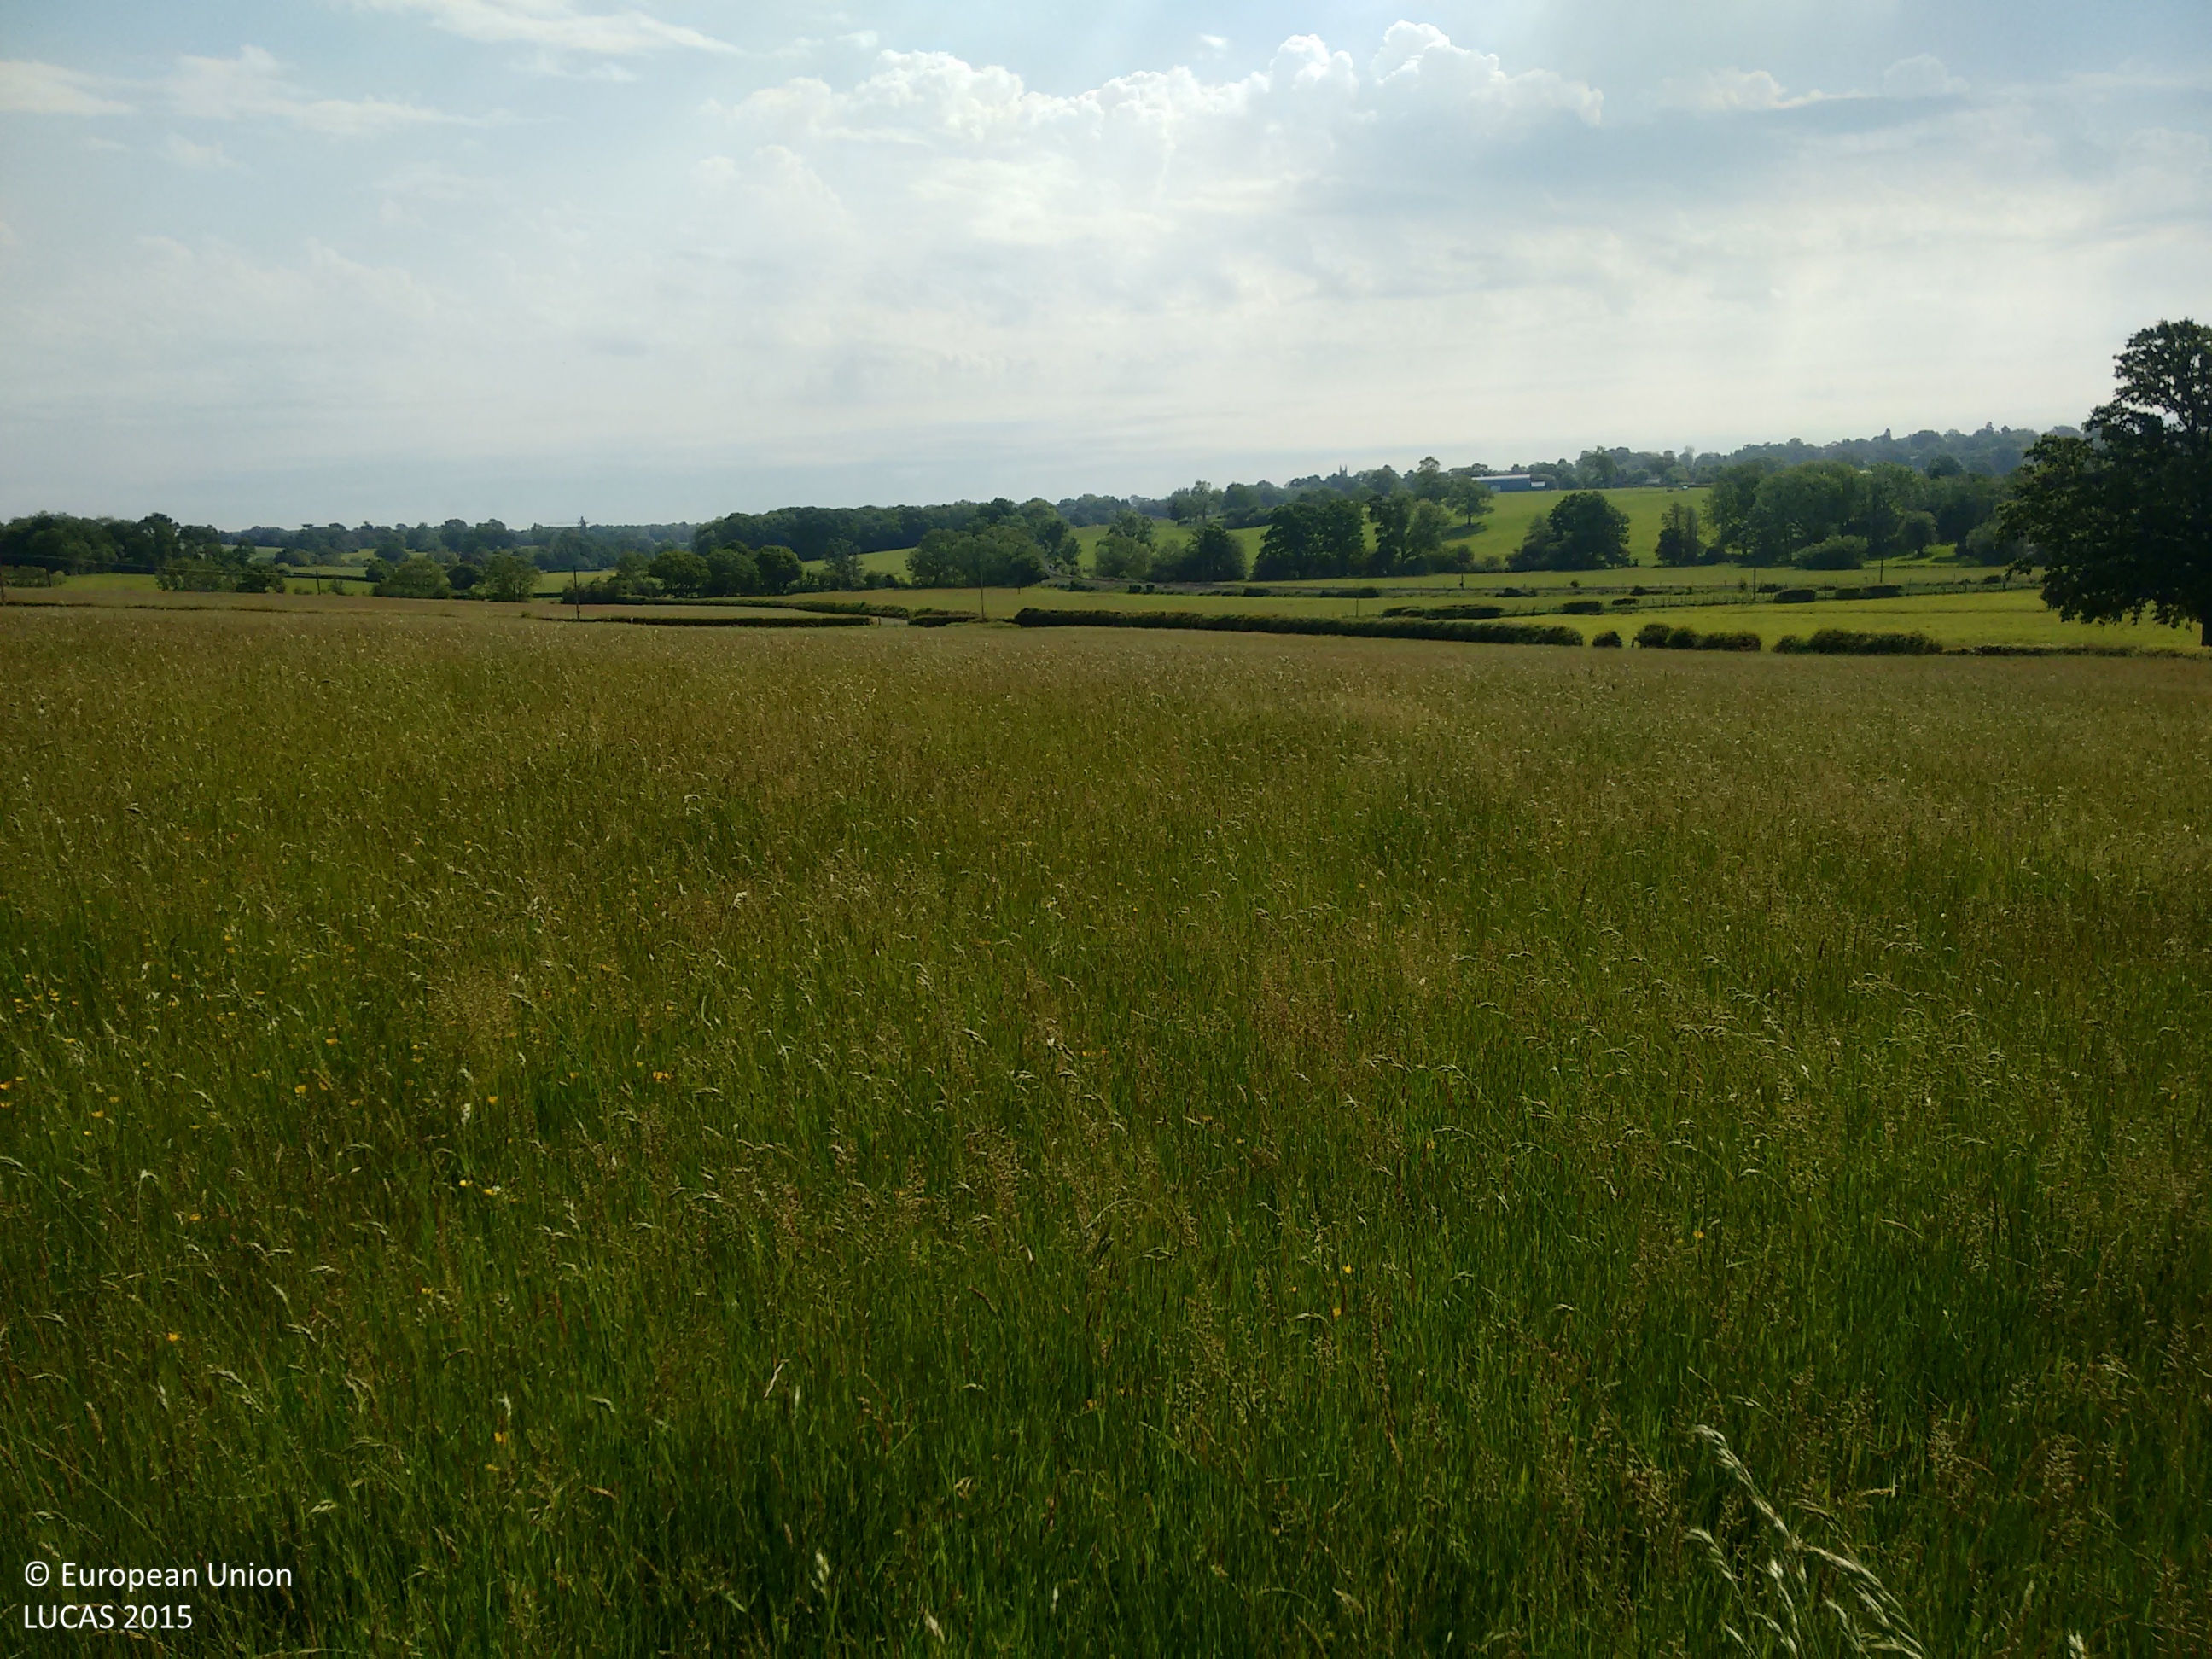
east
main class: Grassland
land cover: Grassland without tree/shrub cover
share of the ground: > 75 %
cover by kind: herbaceous plants 100 %
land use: Agriculture (excluding fallow land and kitchen gardens)
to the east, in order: Grassland without tree/shrub cover; Fences; Managed hedges; Grassland without tree/shrub cover; Fences; Electric lines; Tracks; Fences; Grassland without tree/shrub cover
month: June
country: GB
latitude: 51.0669
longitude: 0.6551
